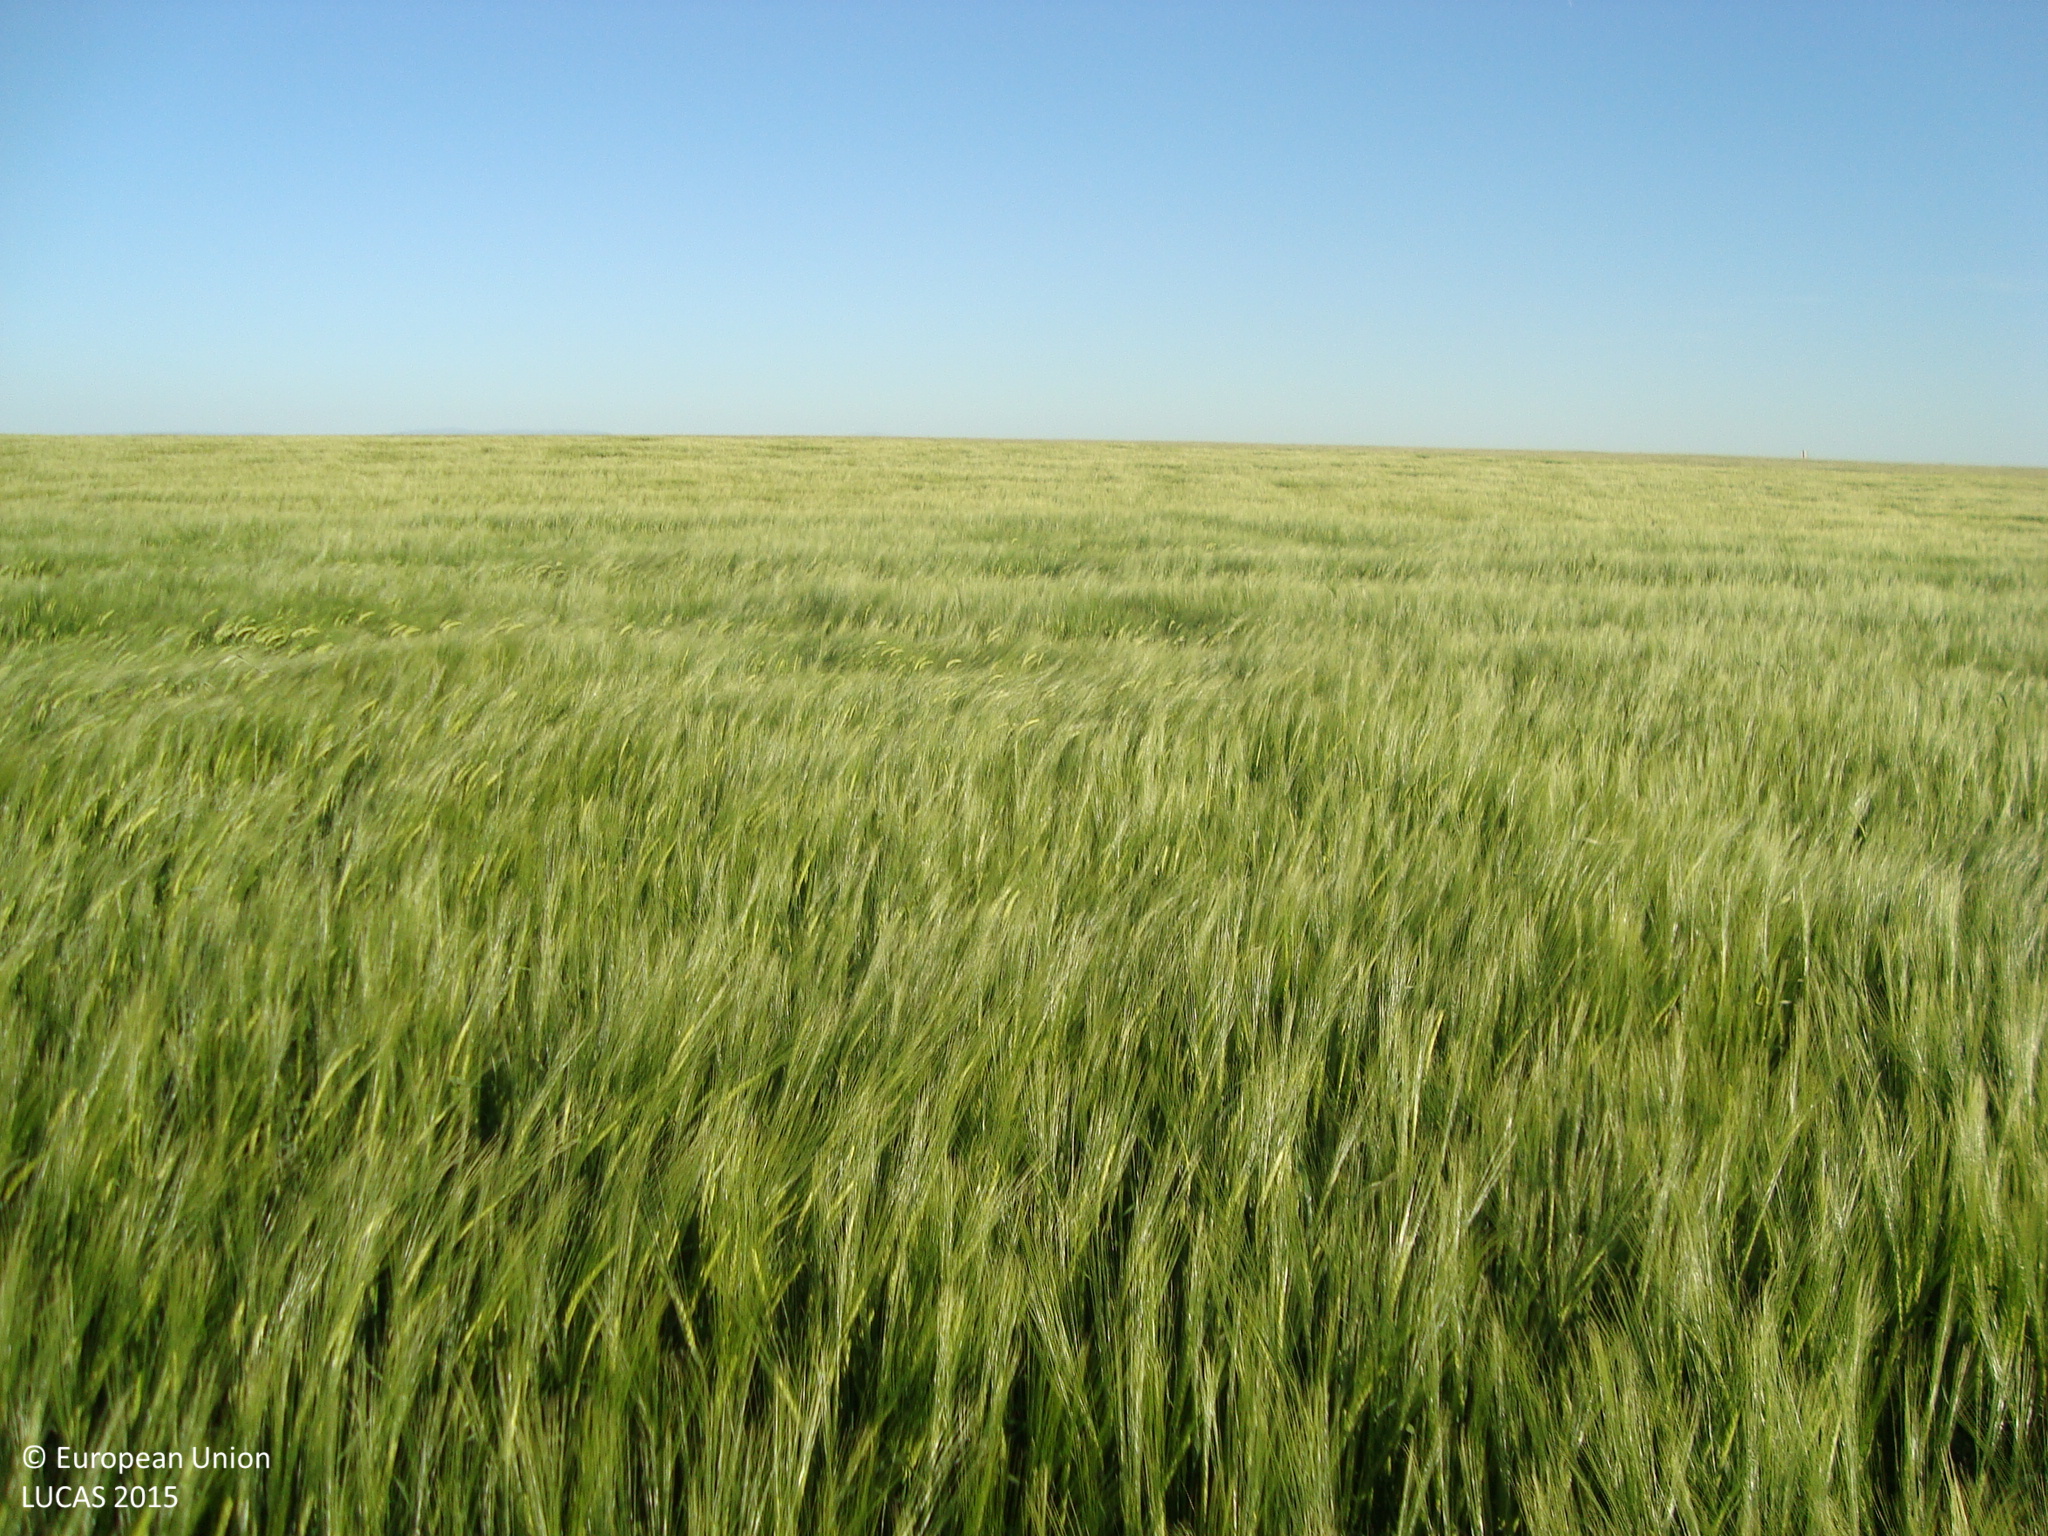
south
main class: Cropland
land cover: Barley
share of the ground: > 75 %
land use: Agriculture (excluding fallow land and kitchen gardens)
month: May
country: ES
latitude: 41.4683
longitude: -4.1746
